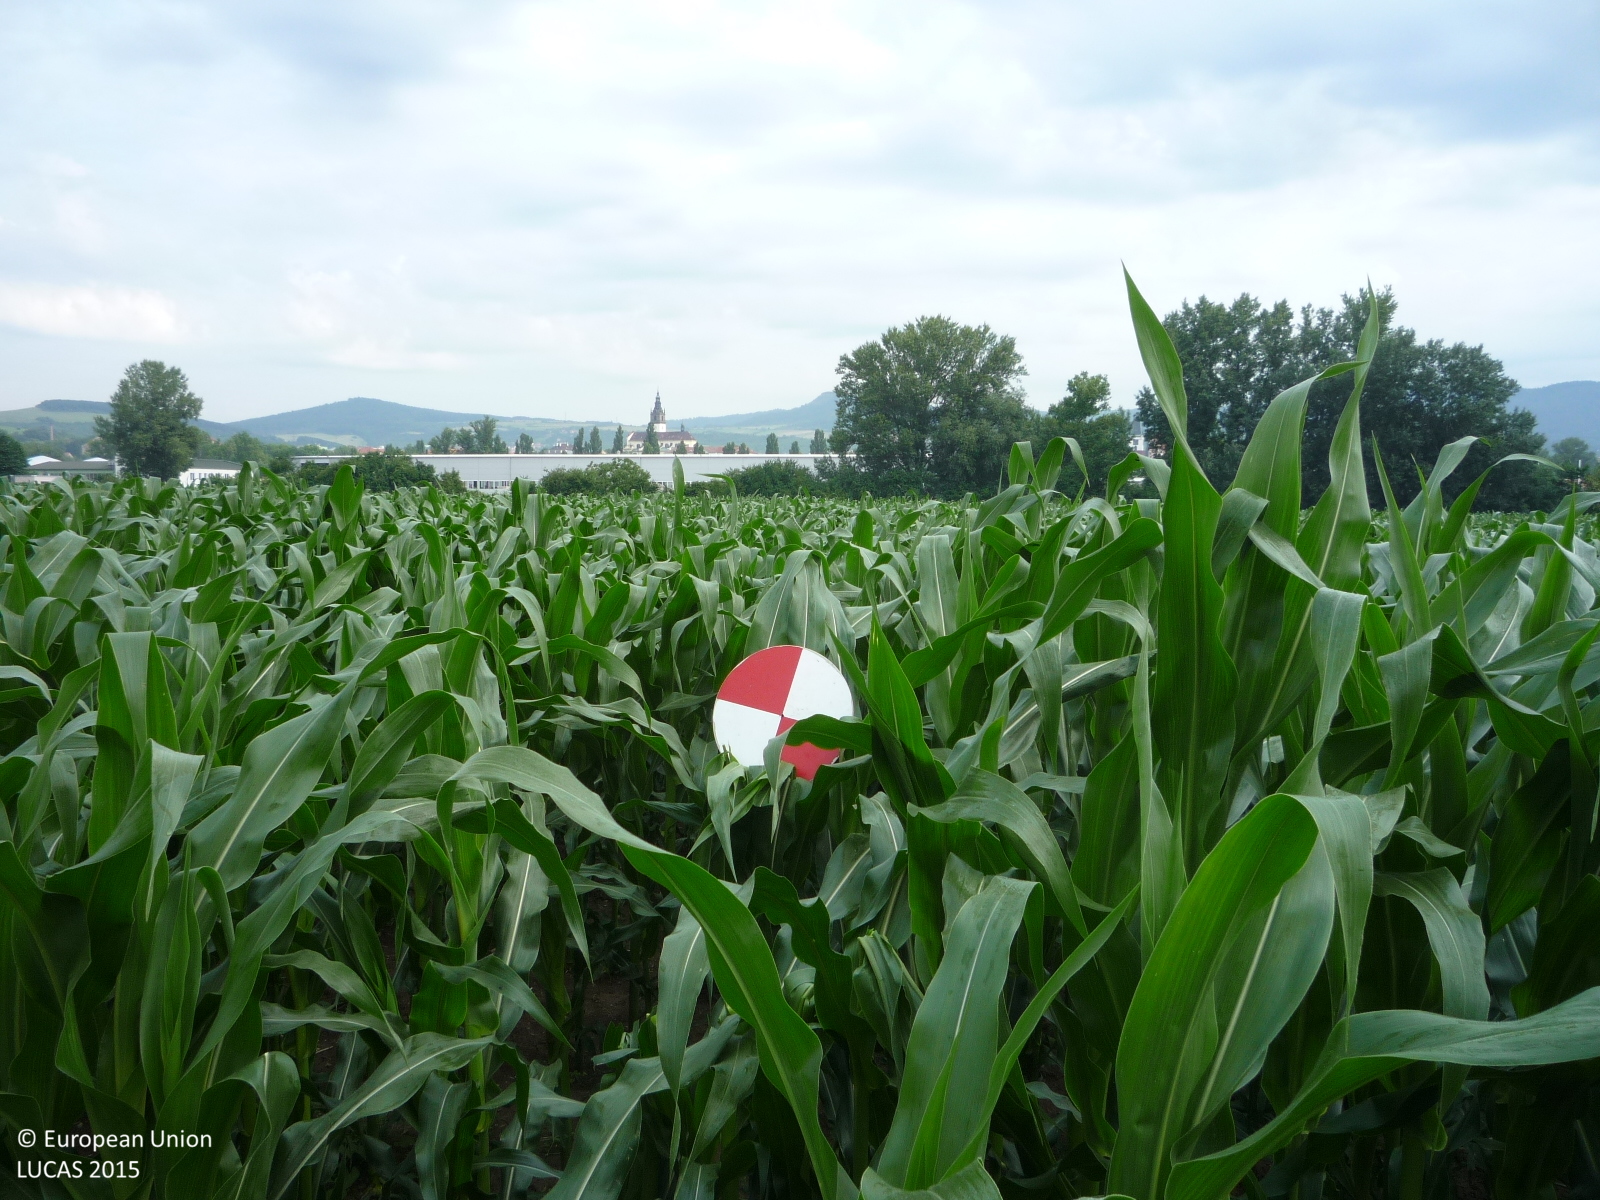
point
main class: Cropland
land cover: Maize
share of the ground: > 75 %
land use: Agriculture (excluding fallow land and kitchen gardens)
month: June
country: CZ
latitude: 50.5234
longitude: 14.1341
